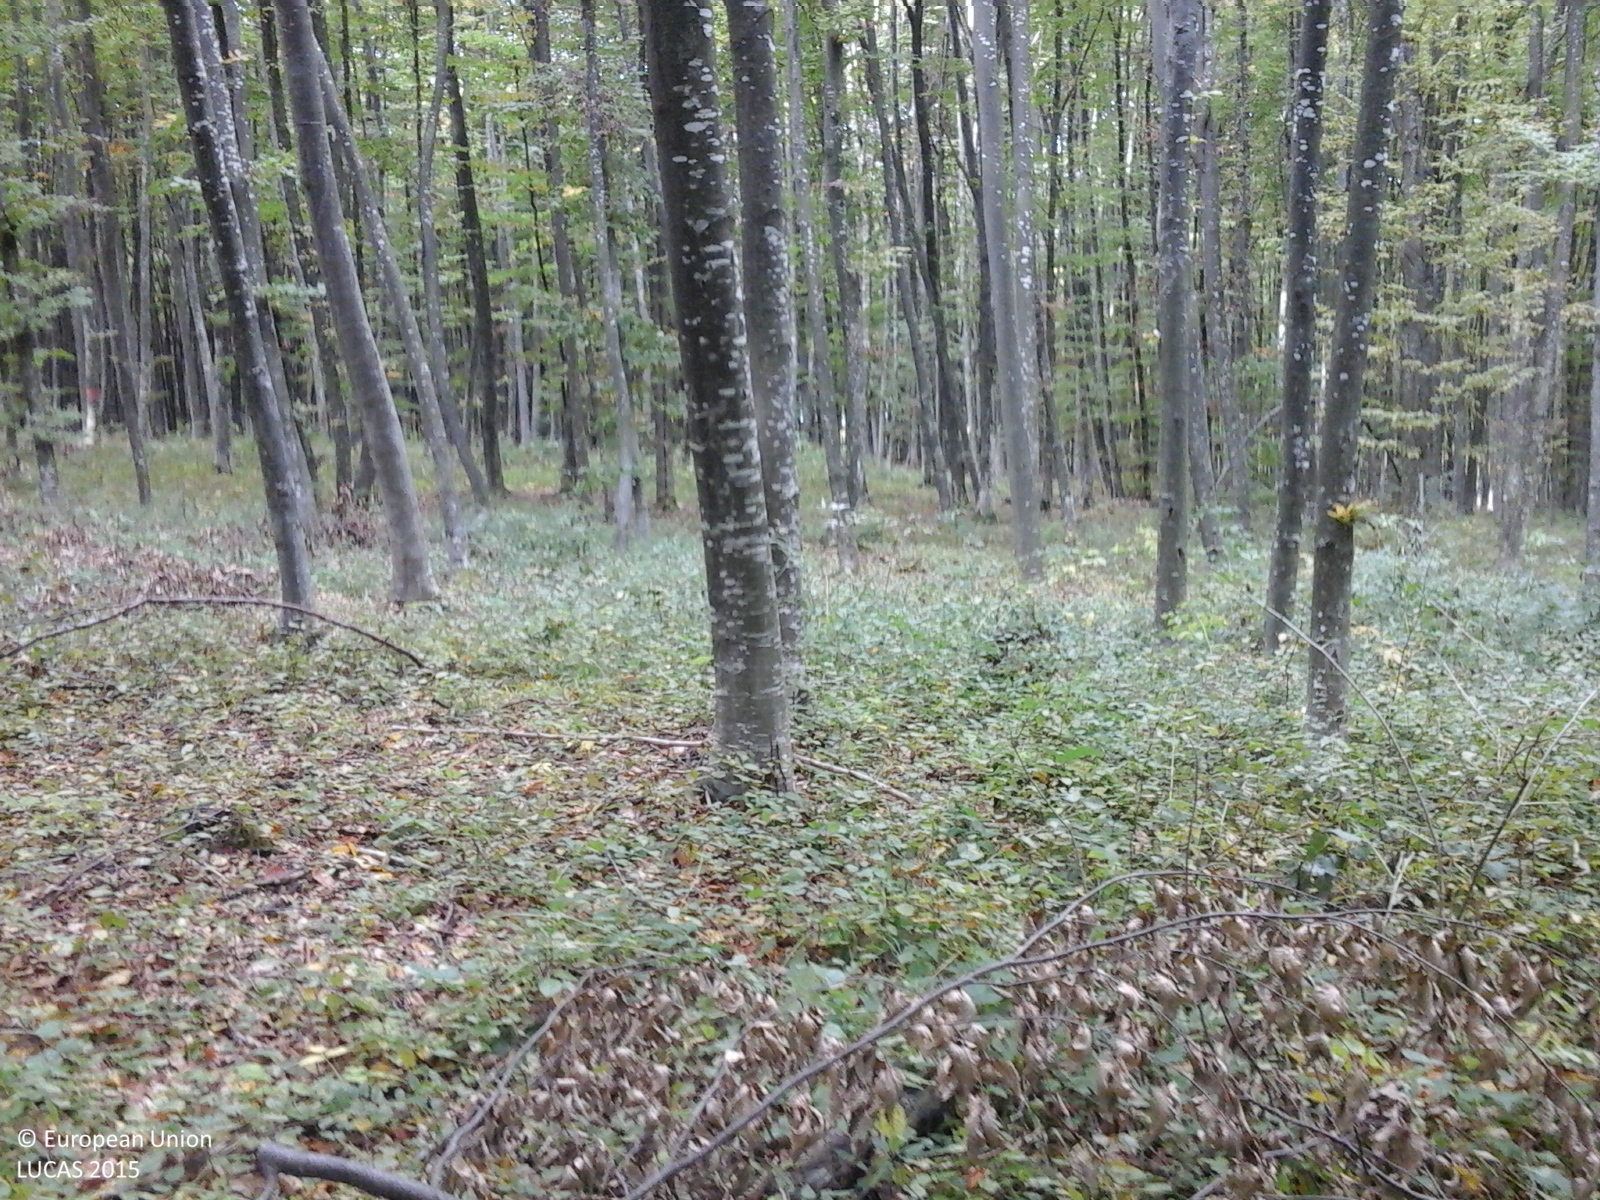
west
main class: Woodland
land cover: Broadleaved woodland
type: beech forest
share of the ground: > 75 %
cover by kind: broadleaved forest trees 100 %
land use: Forestry
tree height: > 5 m
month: October
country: RO
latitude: 46.4599
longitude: 25.1125
